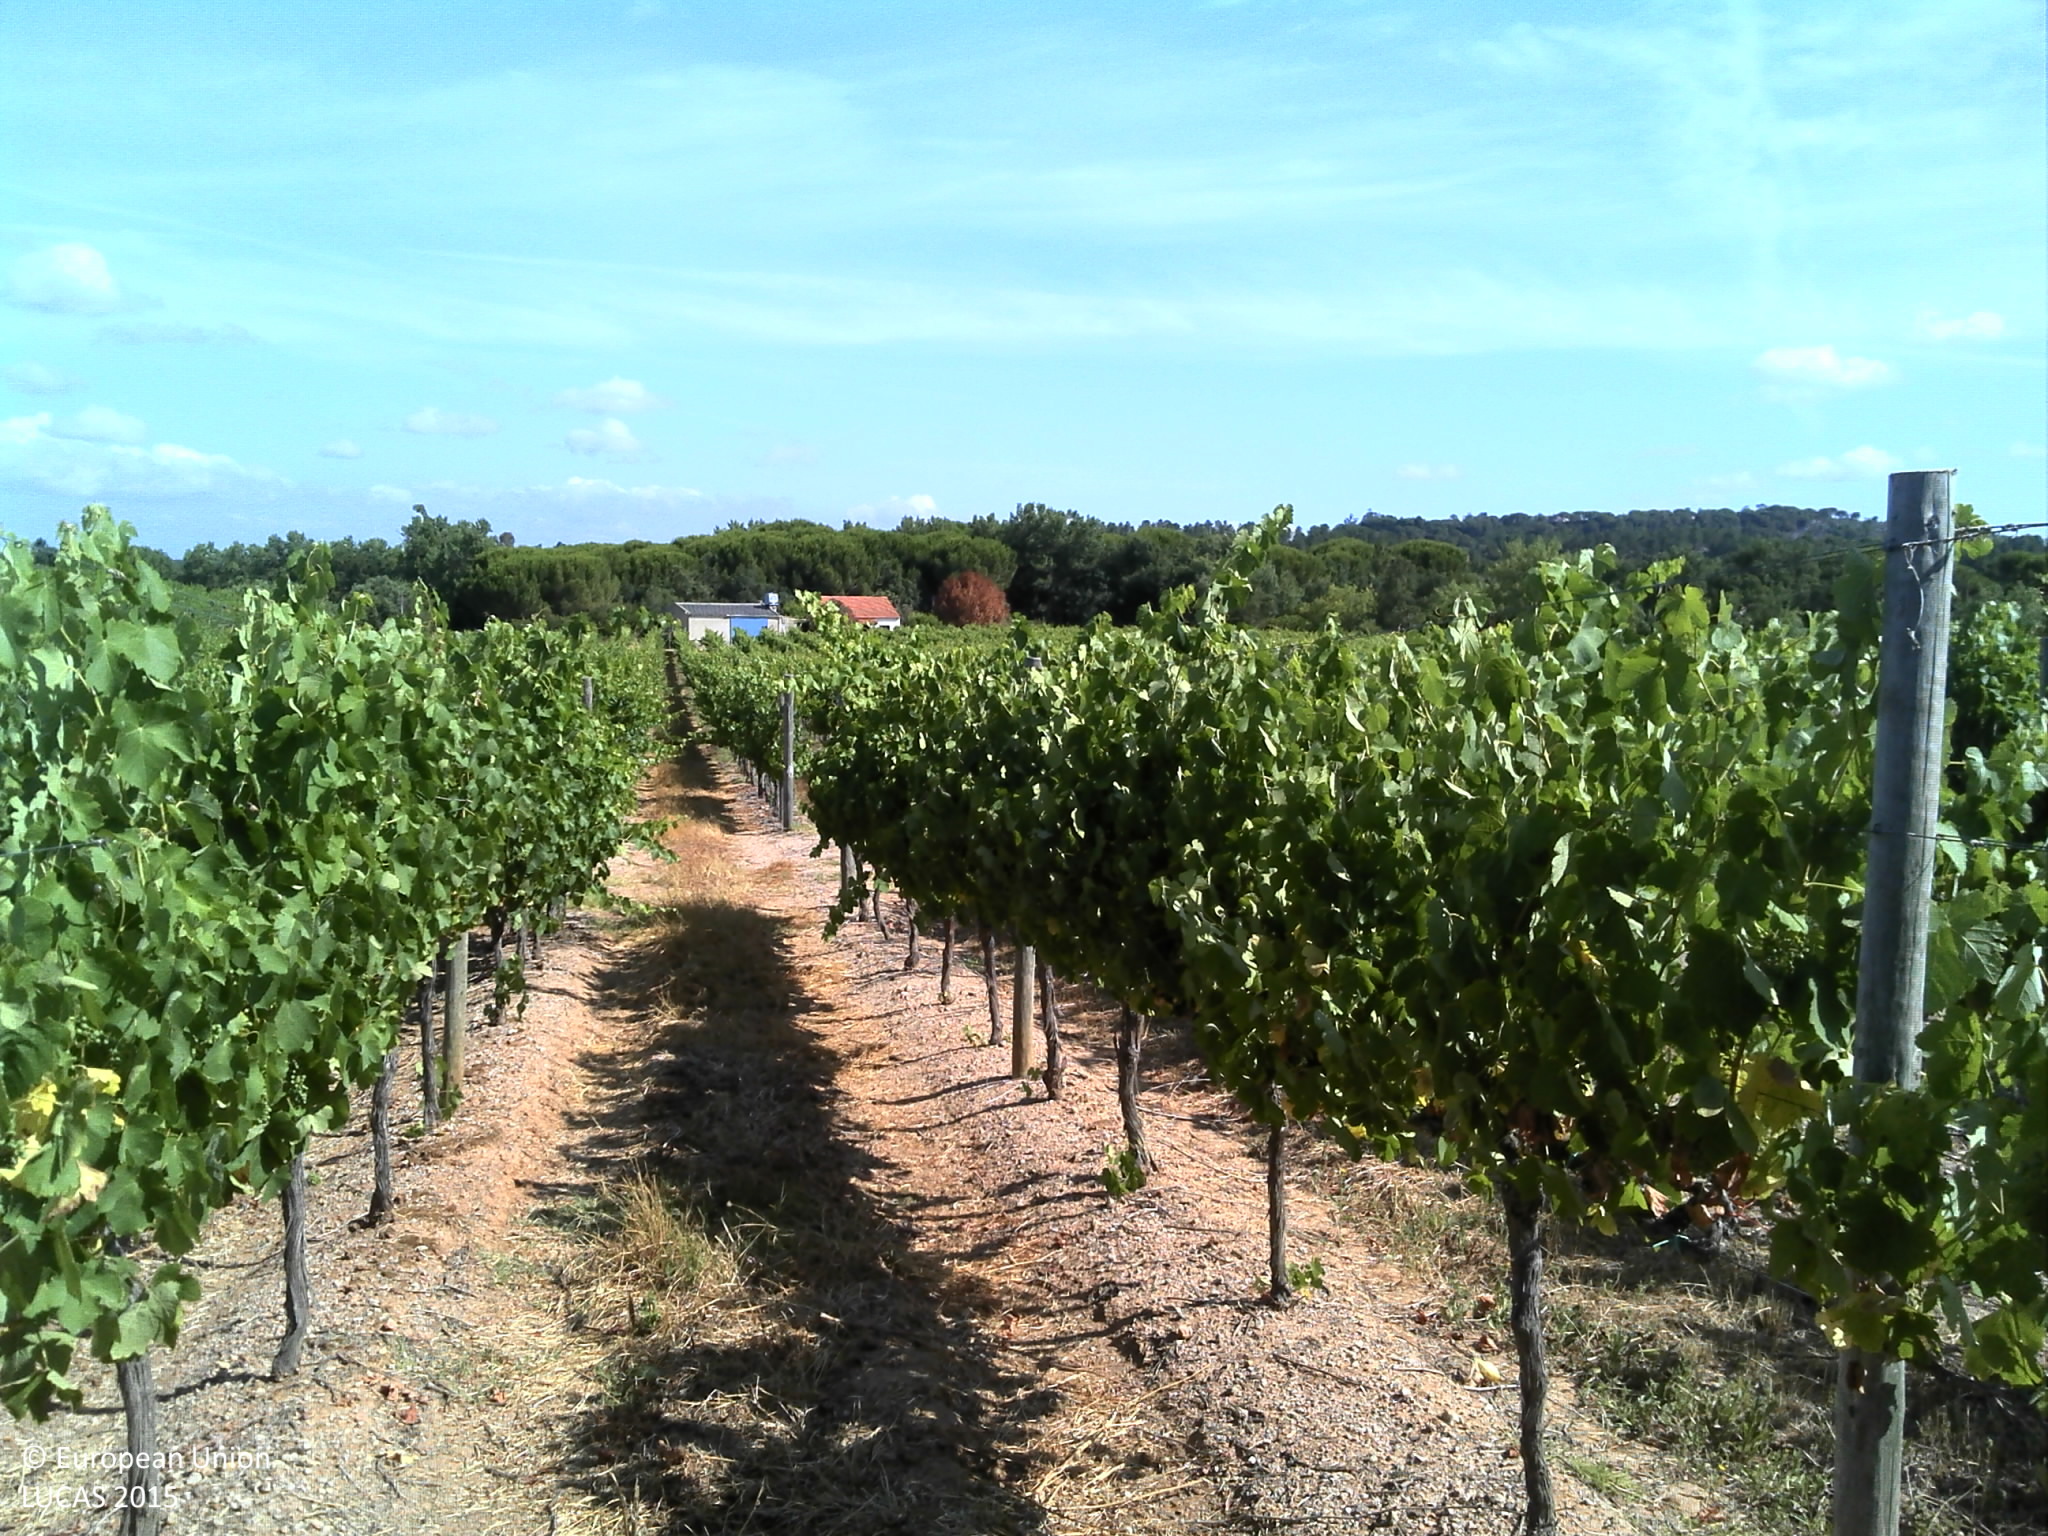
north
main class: Cropland
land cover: Vineyards
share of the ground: 50 - 75 %
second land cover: Grassland without tree/shrub cover
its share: 25 - 50 %
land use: Agriculture (excluding fallow land and kitchen gardens)
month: July
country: PT
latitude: 38.4762
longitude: -9.0379
